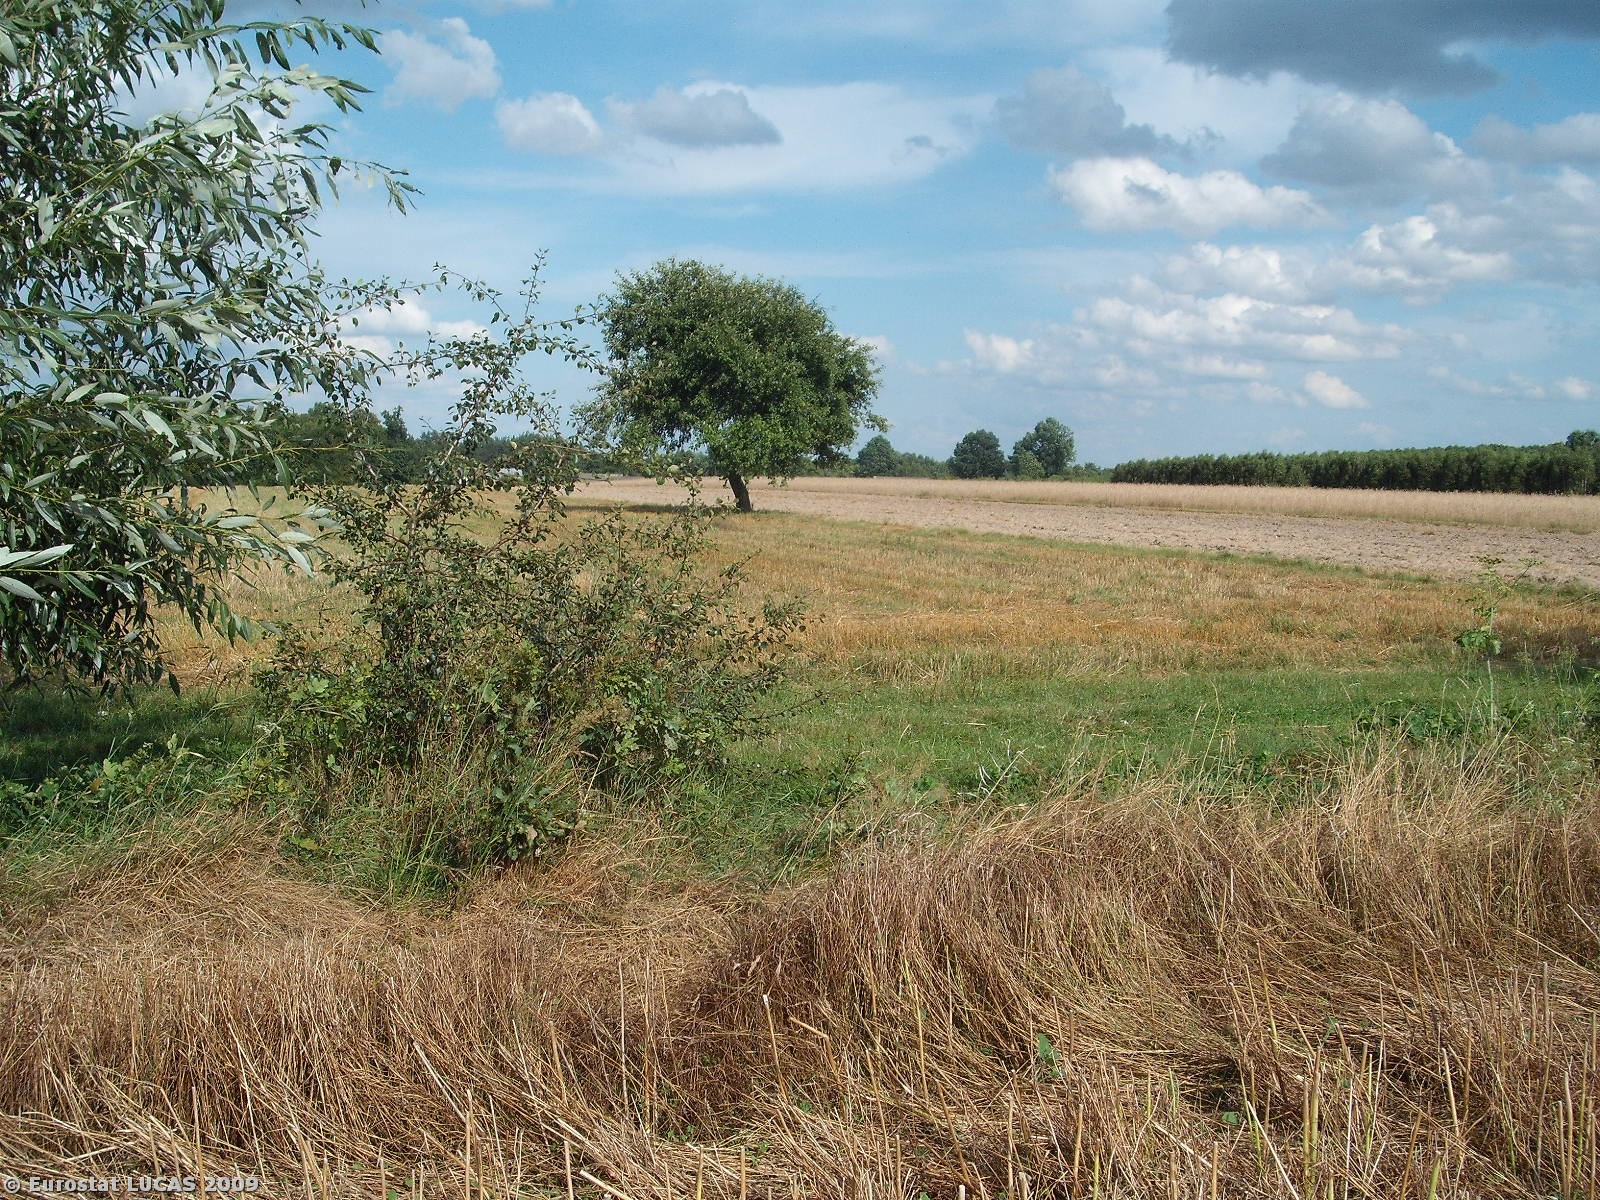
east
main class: Cropland
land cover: Other fibre and oleaginous crops
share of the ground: < 10 %
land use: Agriculture (excluding fallow land and kitchen gardens)
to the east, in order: Other fibre and oleaginous crops; Single bushes/trees; Tracks; Rye; Single bushes/trees; Rye; Grass margins; Triticale; Mixed cereals for fodder
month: August
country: PL
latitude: 51.8408
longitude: 21.6208
